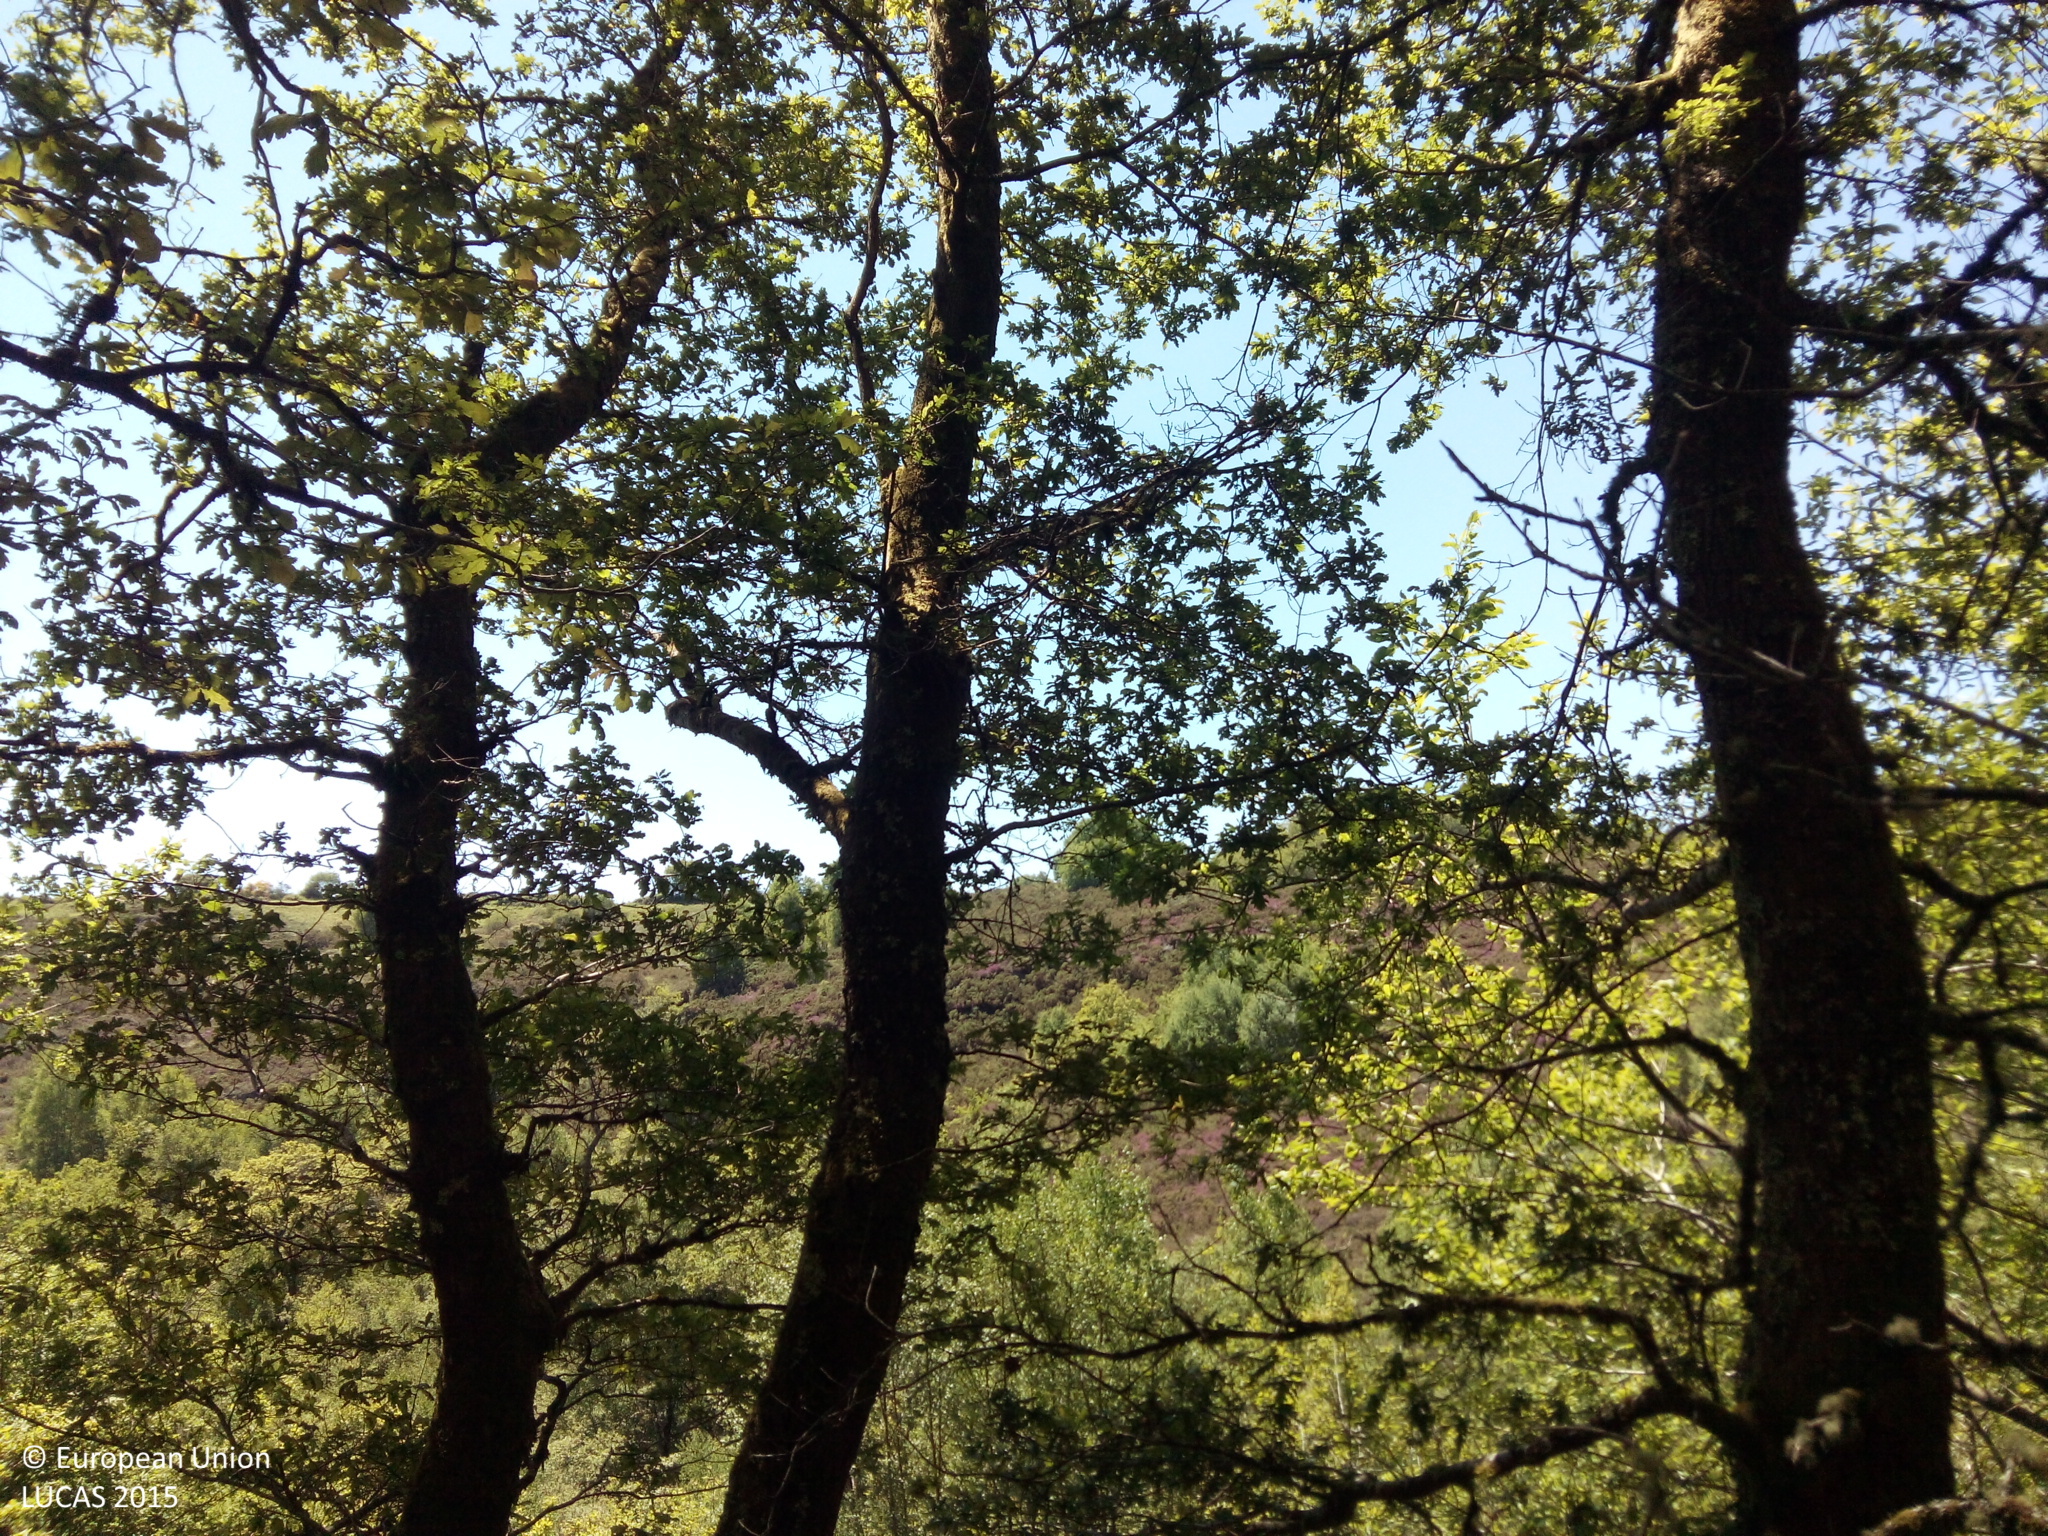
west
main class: Woodland
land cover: Broadleaved woodland
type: acidophilous oak and oak-birch forest
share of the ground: > 75 %
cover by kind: broadleaved forest trees 100 %
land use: Forestry
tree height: > 5 m
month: May
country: ES
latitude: 42.6015
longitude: -8.3657
